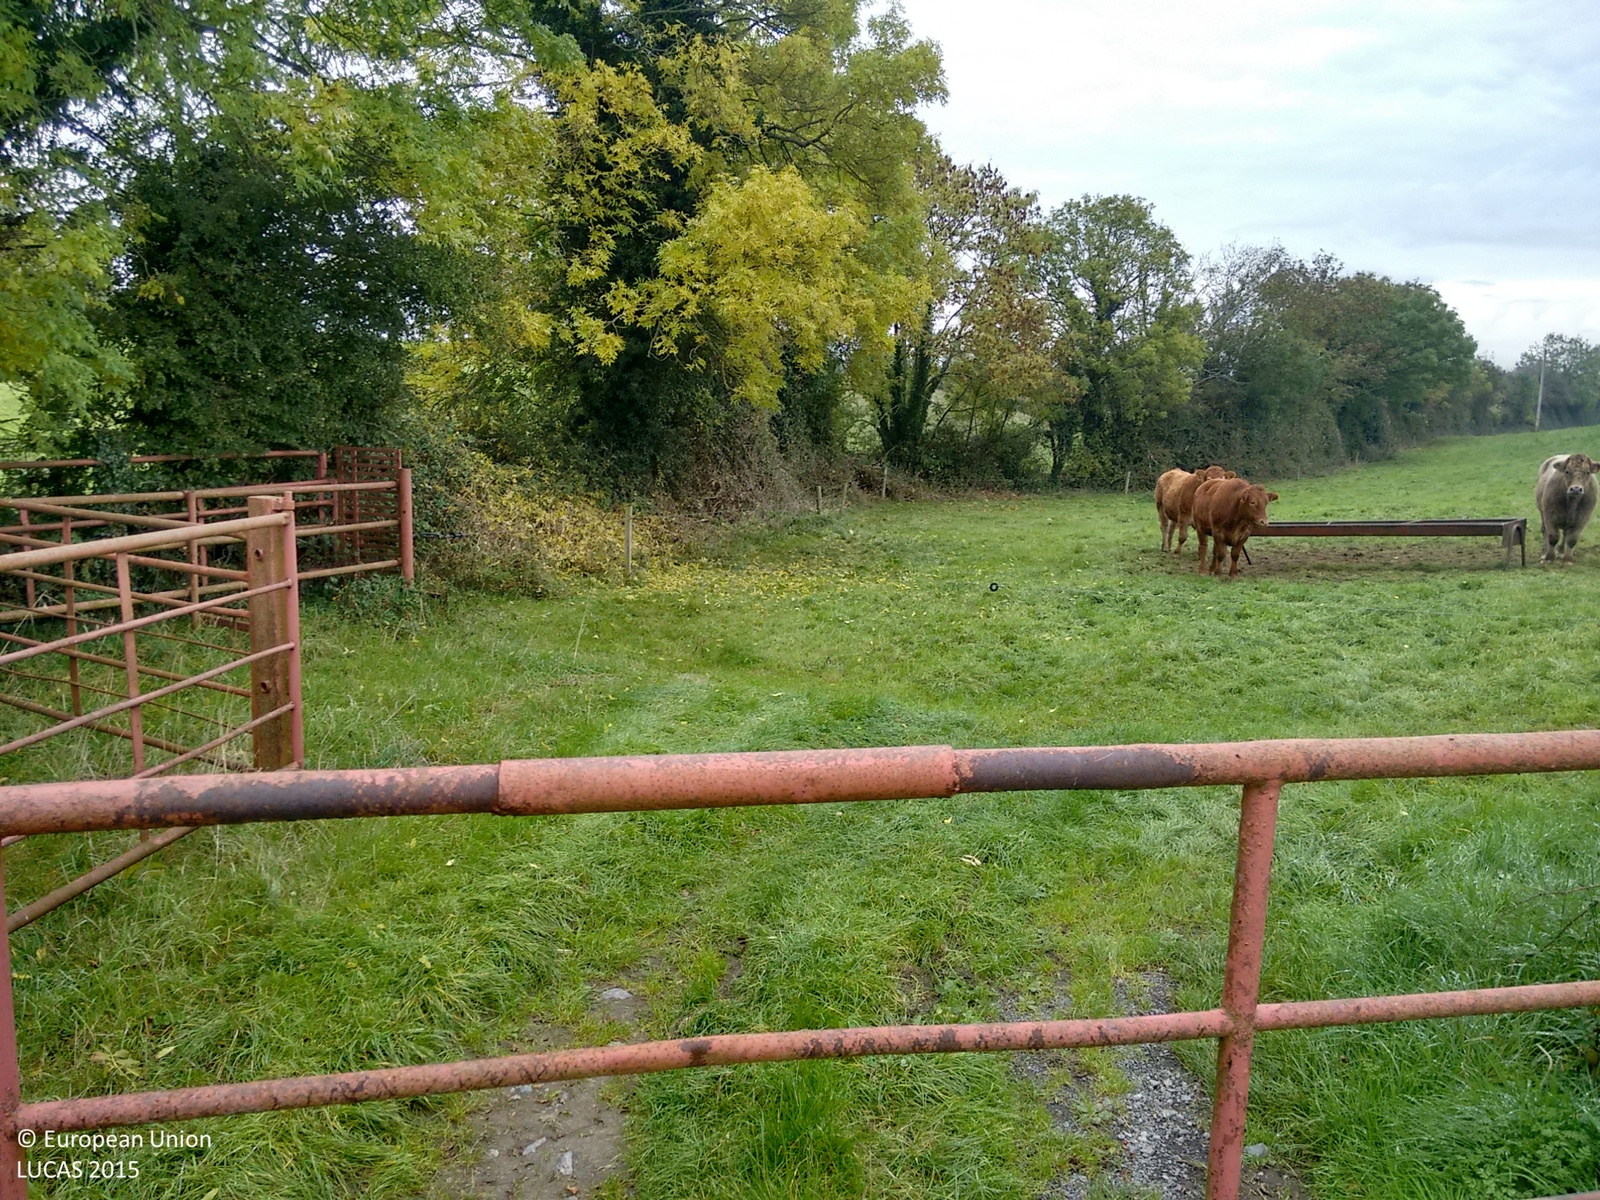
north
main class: Grassland
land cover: Grassland without tree/shrub cover
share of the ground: > 75 %
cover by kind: herbaceous plants 95 %
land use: Agriculture (excluding fallow land and kitchen gardens)
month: October
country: IE
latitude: 52.8125
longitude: -7.5025
